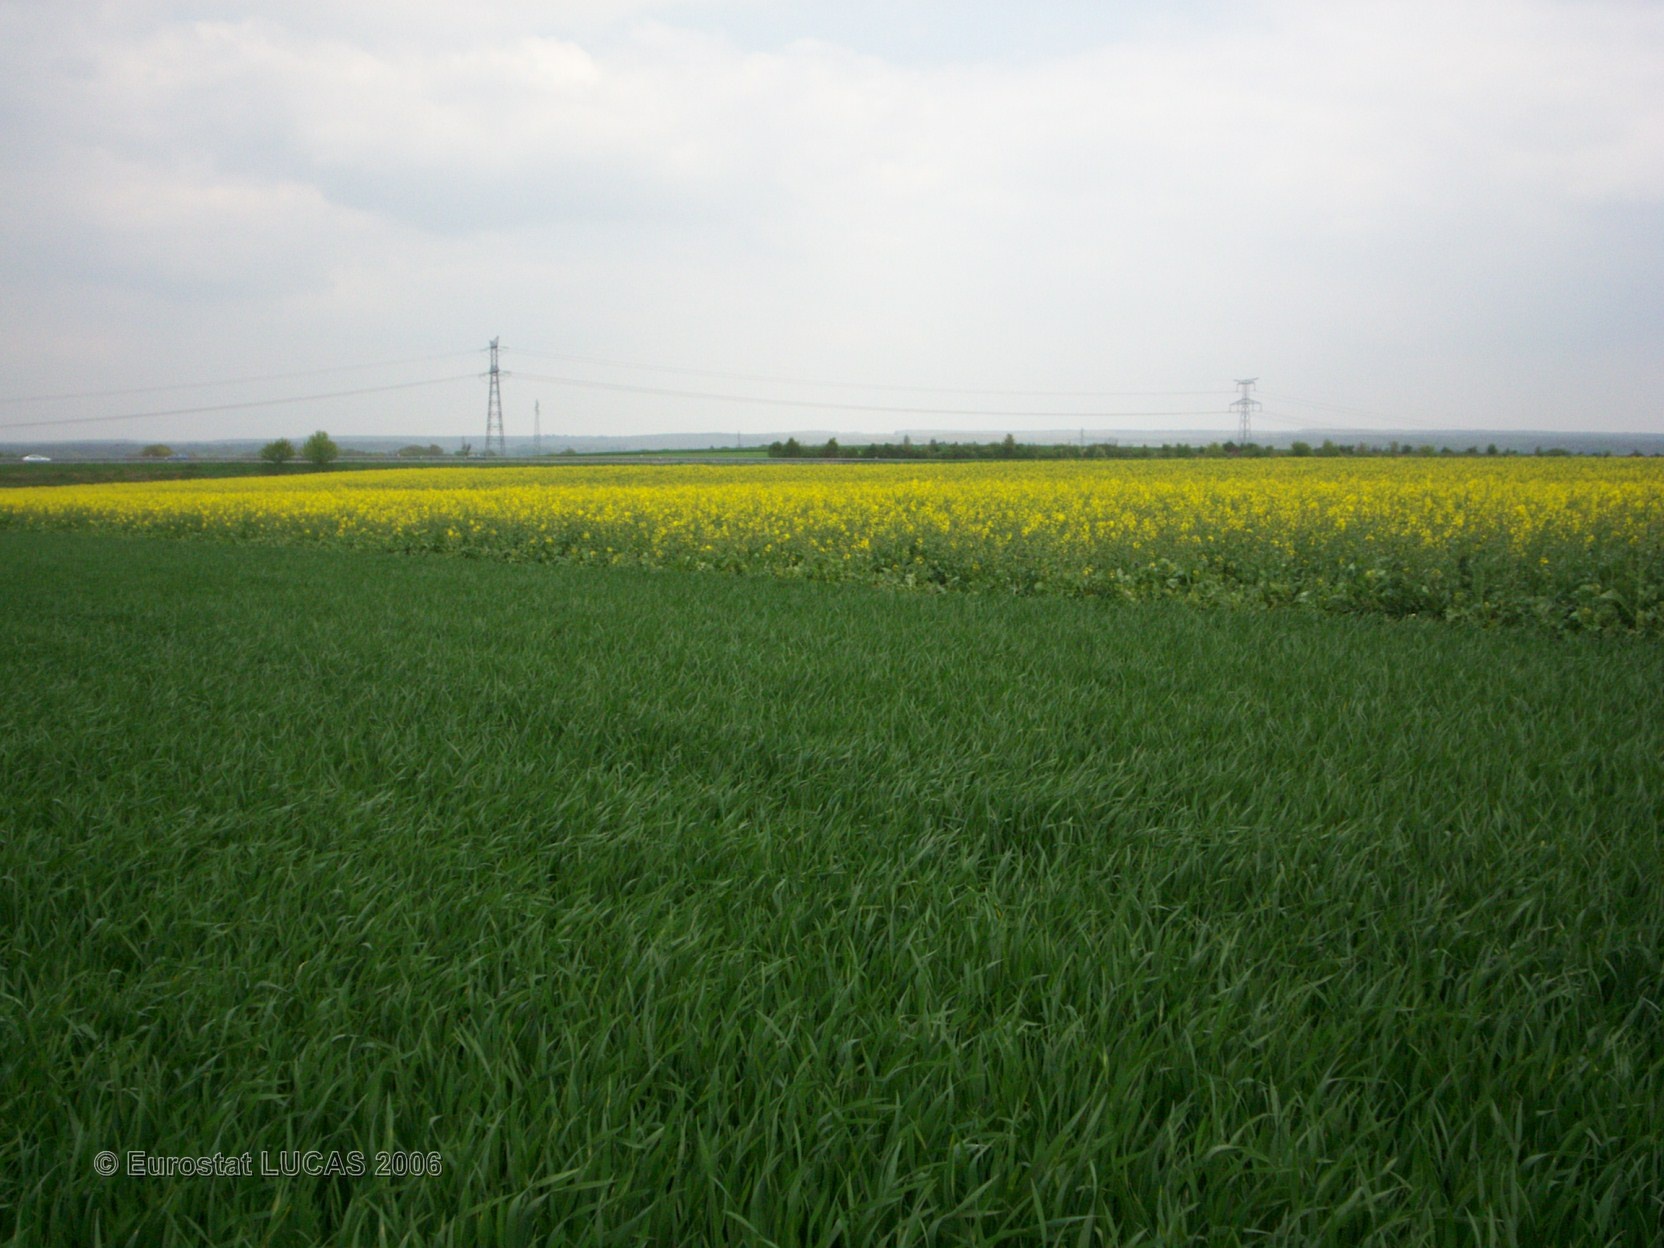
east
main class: Cropland
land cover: Common wheat
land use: Agriculture (excluding fallow land and kitchen gardens)
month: April
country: FR
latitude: 47.1727
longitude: 3.0423
